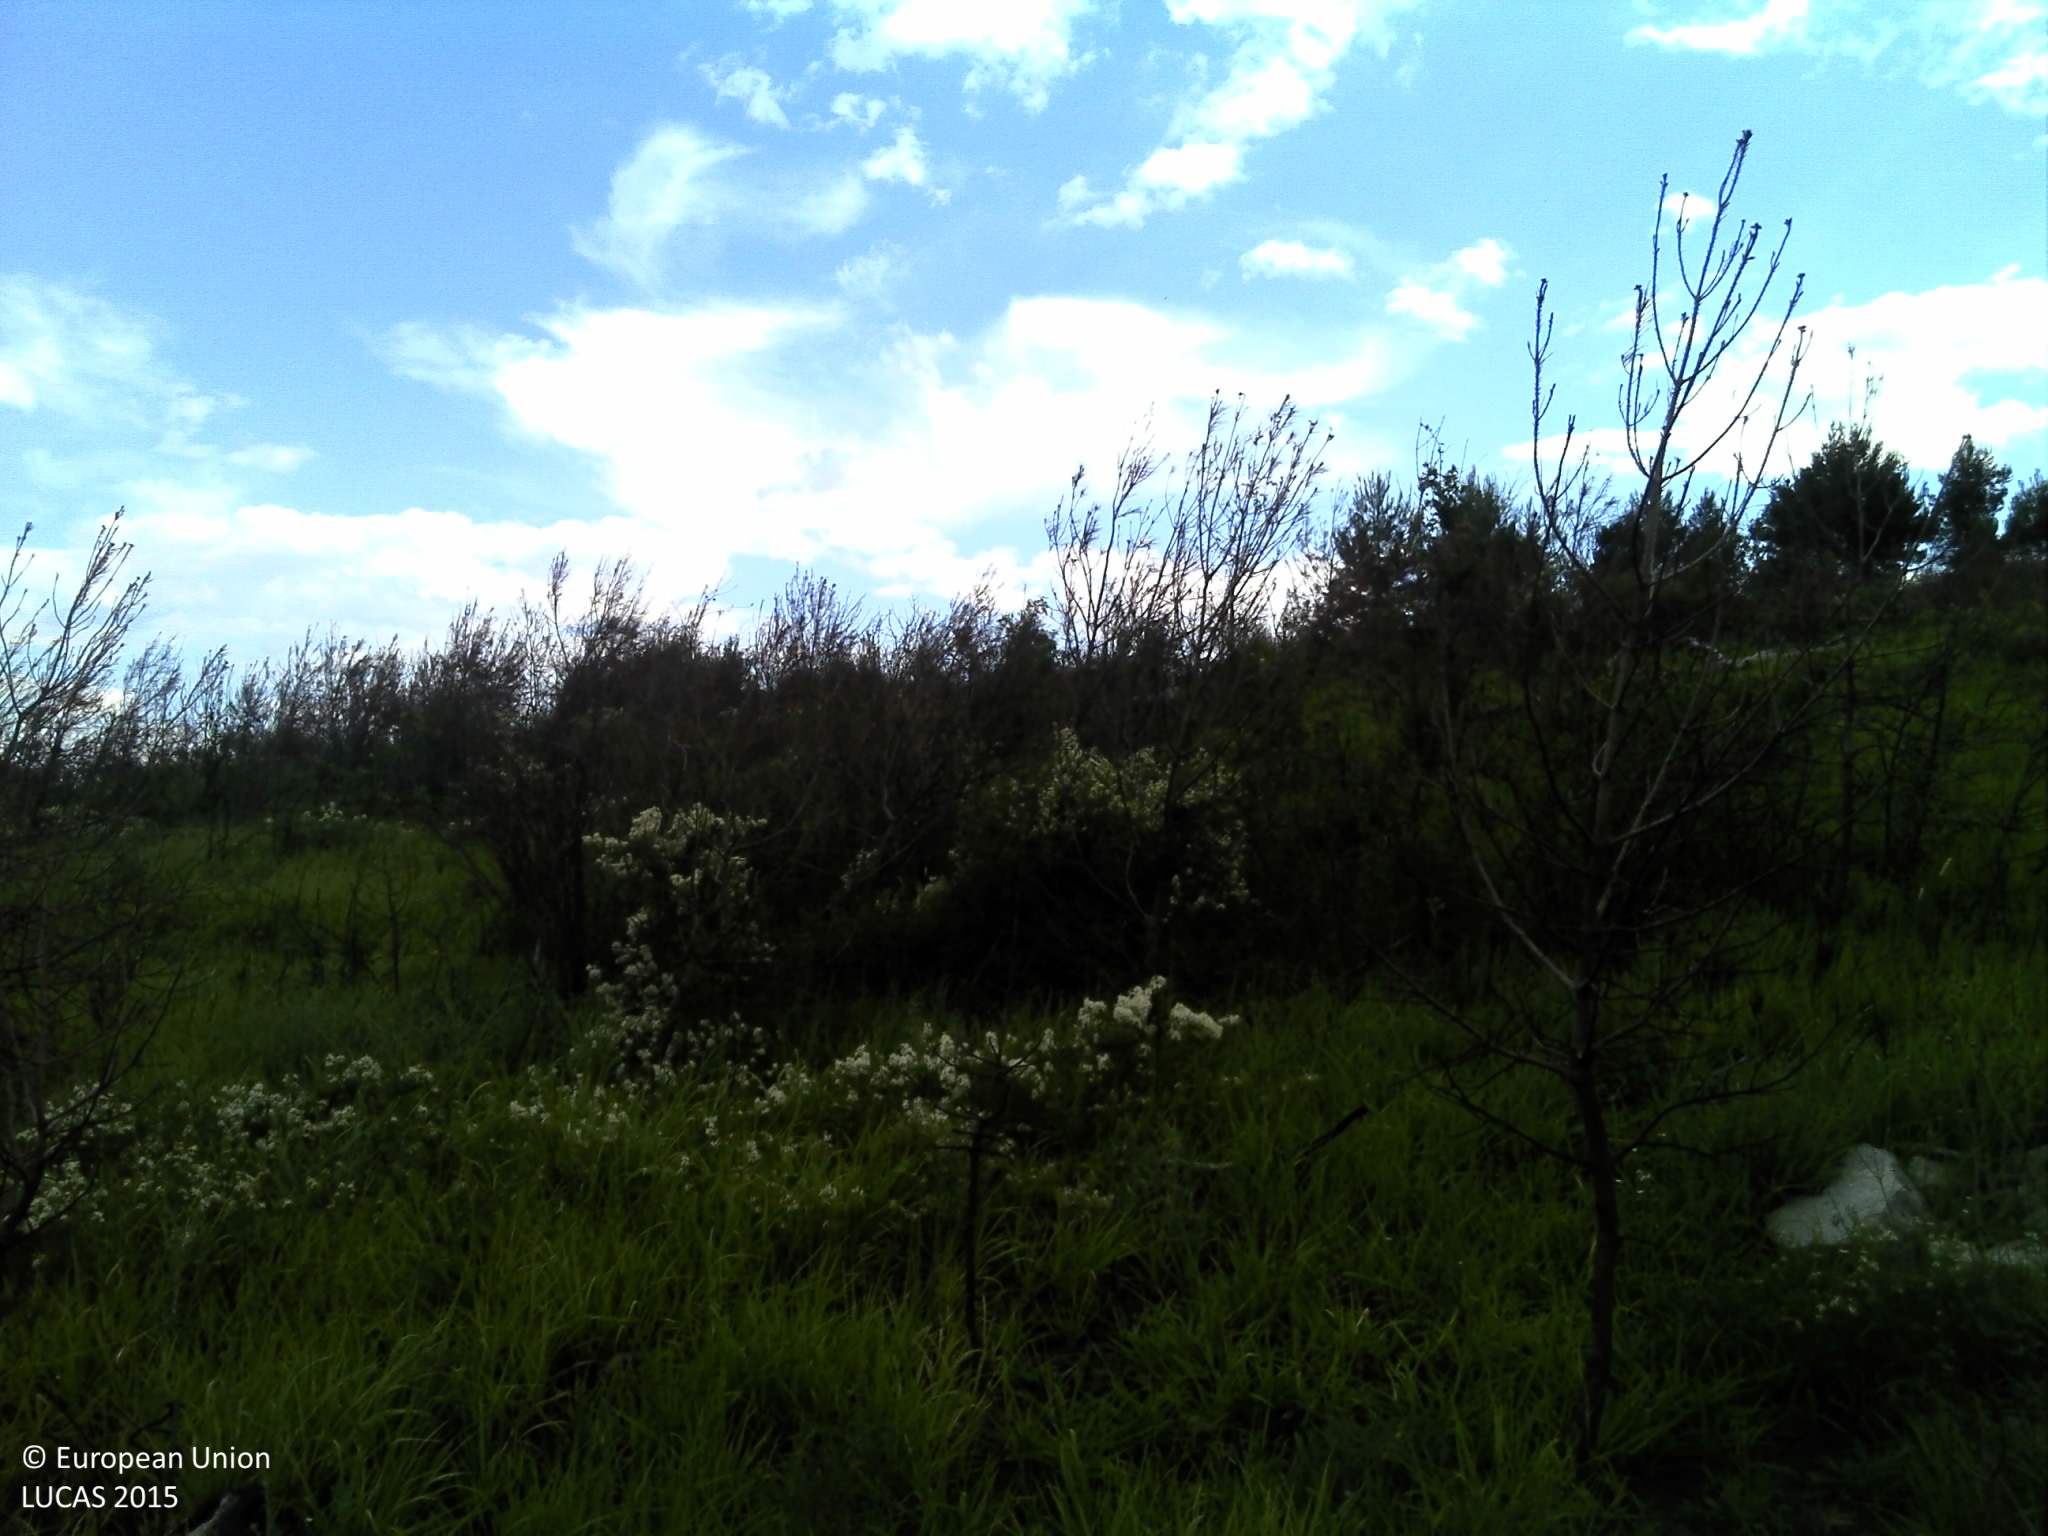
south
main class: Grassland
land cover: Spontaneously vegetated surfaces
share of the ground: > 75 %
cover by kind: herbaceous plants 80 %, shrubs 5 %, lichens and mosses 5 %, consolidated bare surface 5 %, unconsolidated bare surface 5 %
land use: Semi-natural and natural areas not in use
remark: Burnt area
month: June
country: HR
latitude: 43.5487
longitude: 16.5140
